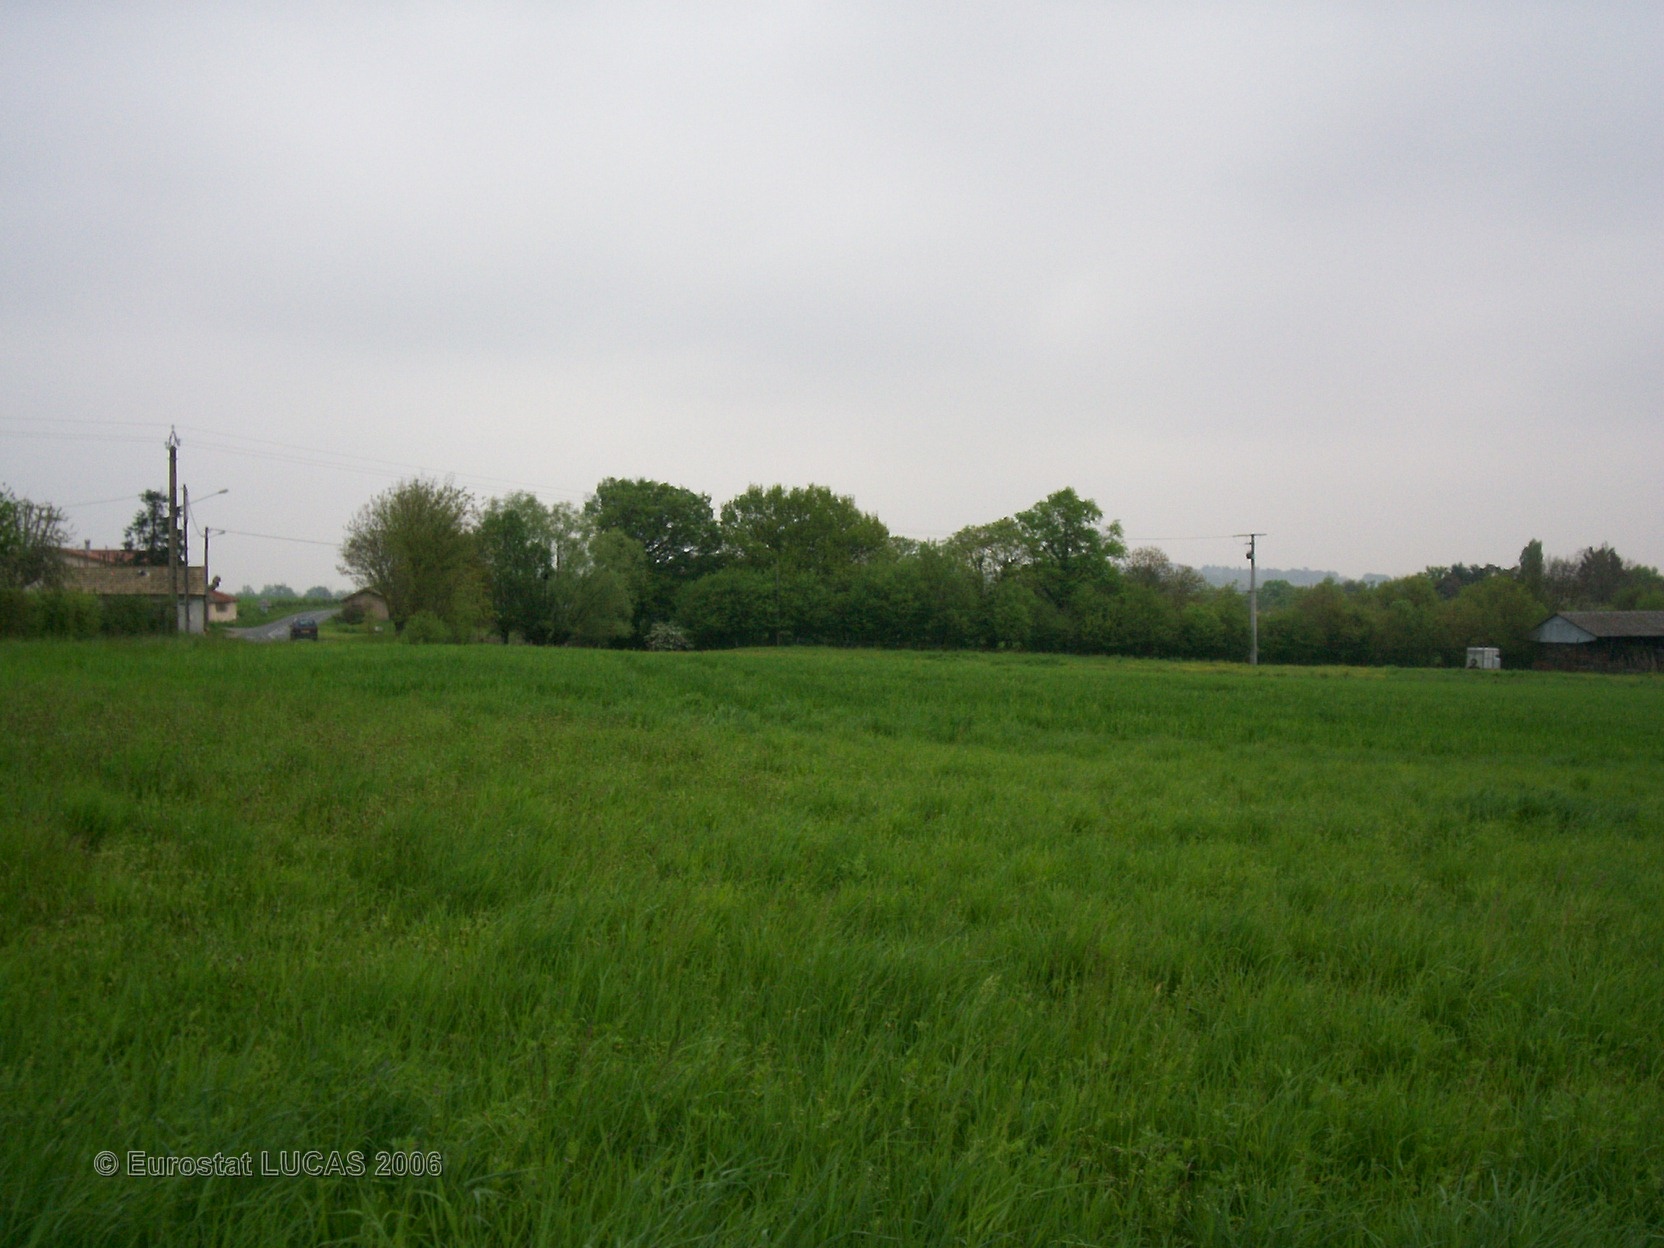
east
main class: Cropland
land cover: Common wheat
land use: Agriculture (excluding fallow land and kitchen gardens)
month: April
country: FR
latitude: 46.0799
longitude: 4.7915
